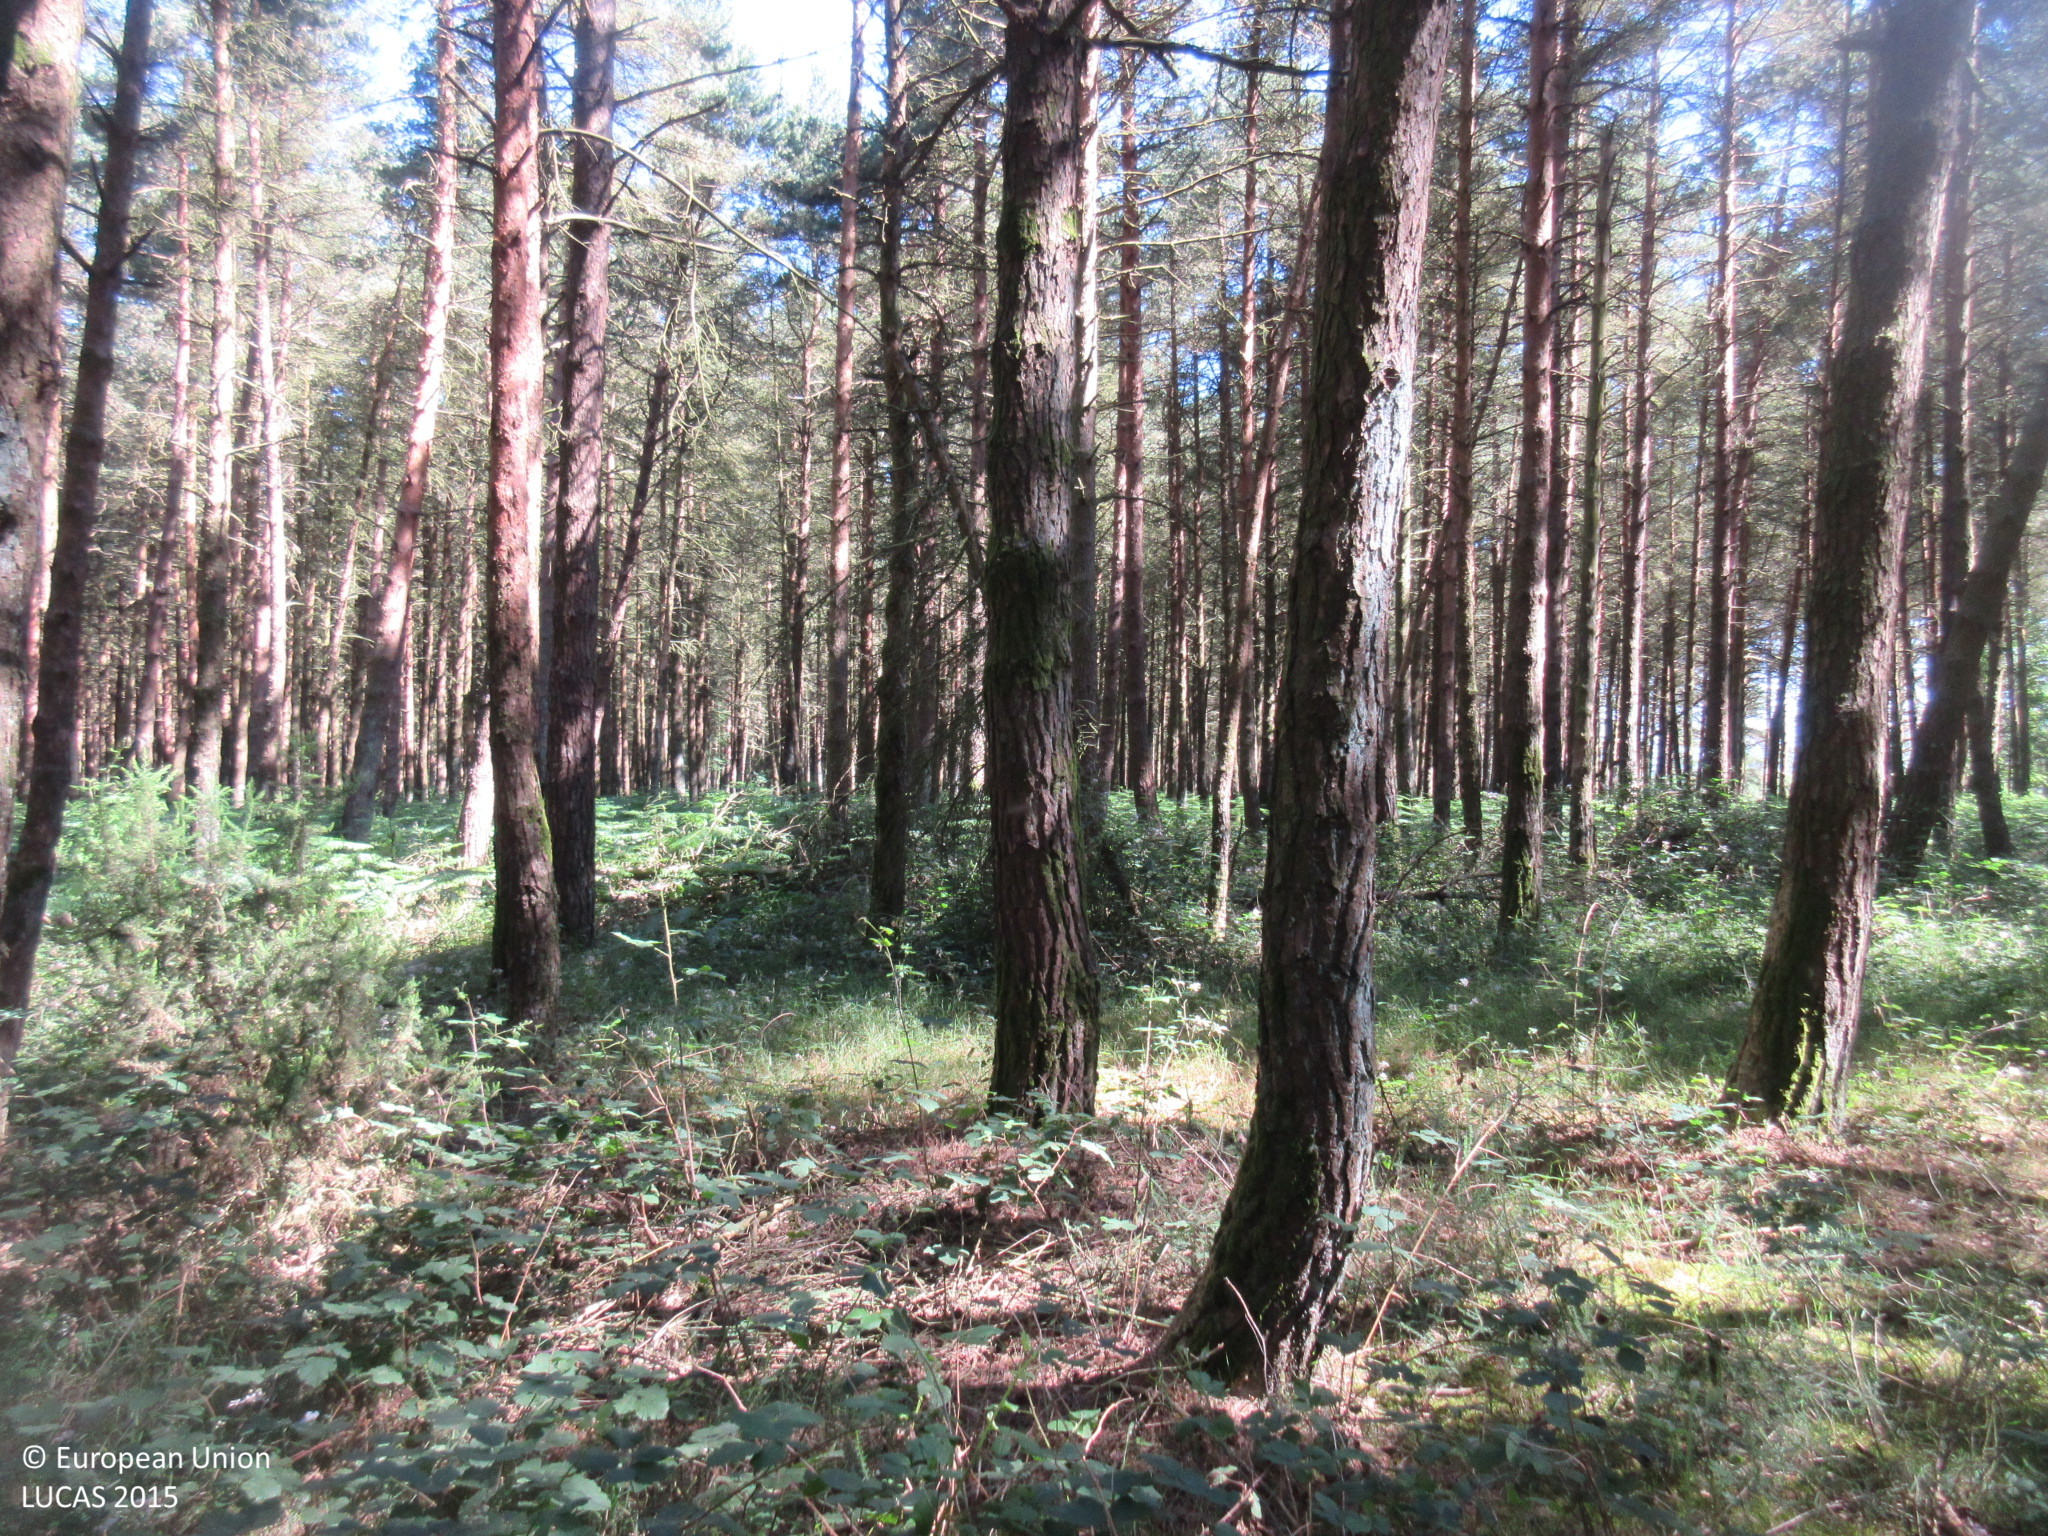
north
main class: Woodland
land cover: Pine dominated coniferous woodland
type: hemiboreal forest and nemoral coniferous forest and mixed broadleaved-coniferous forest
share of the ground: > 75 %
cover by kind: coniferous forest trees 95 %, shrubs 5 %
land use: Forestry
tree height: > 5 m
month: June
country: ES
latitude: 43.1751
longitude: -7.1048
